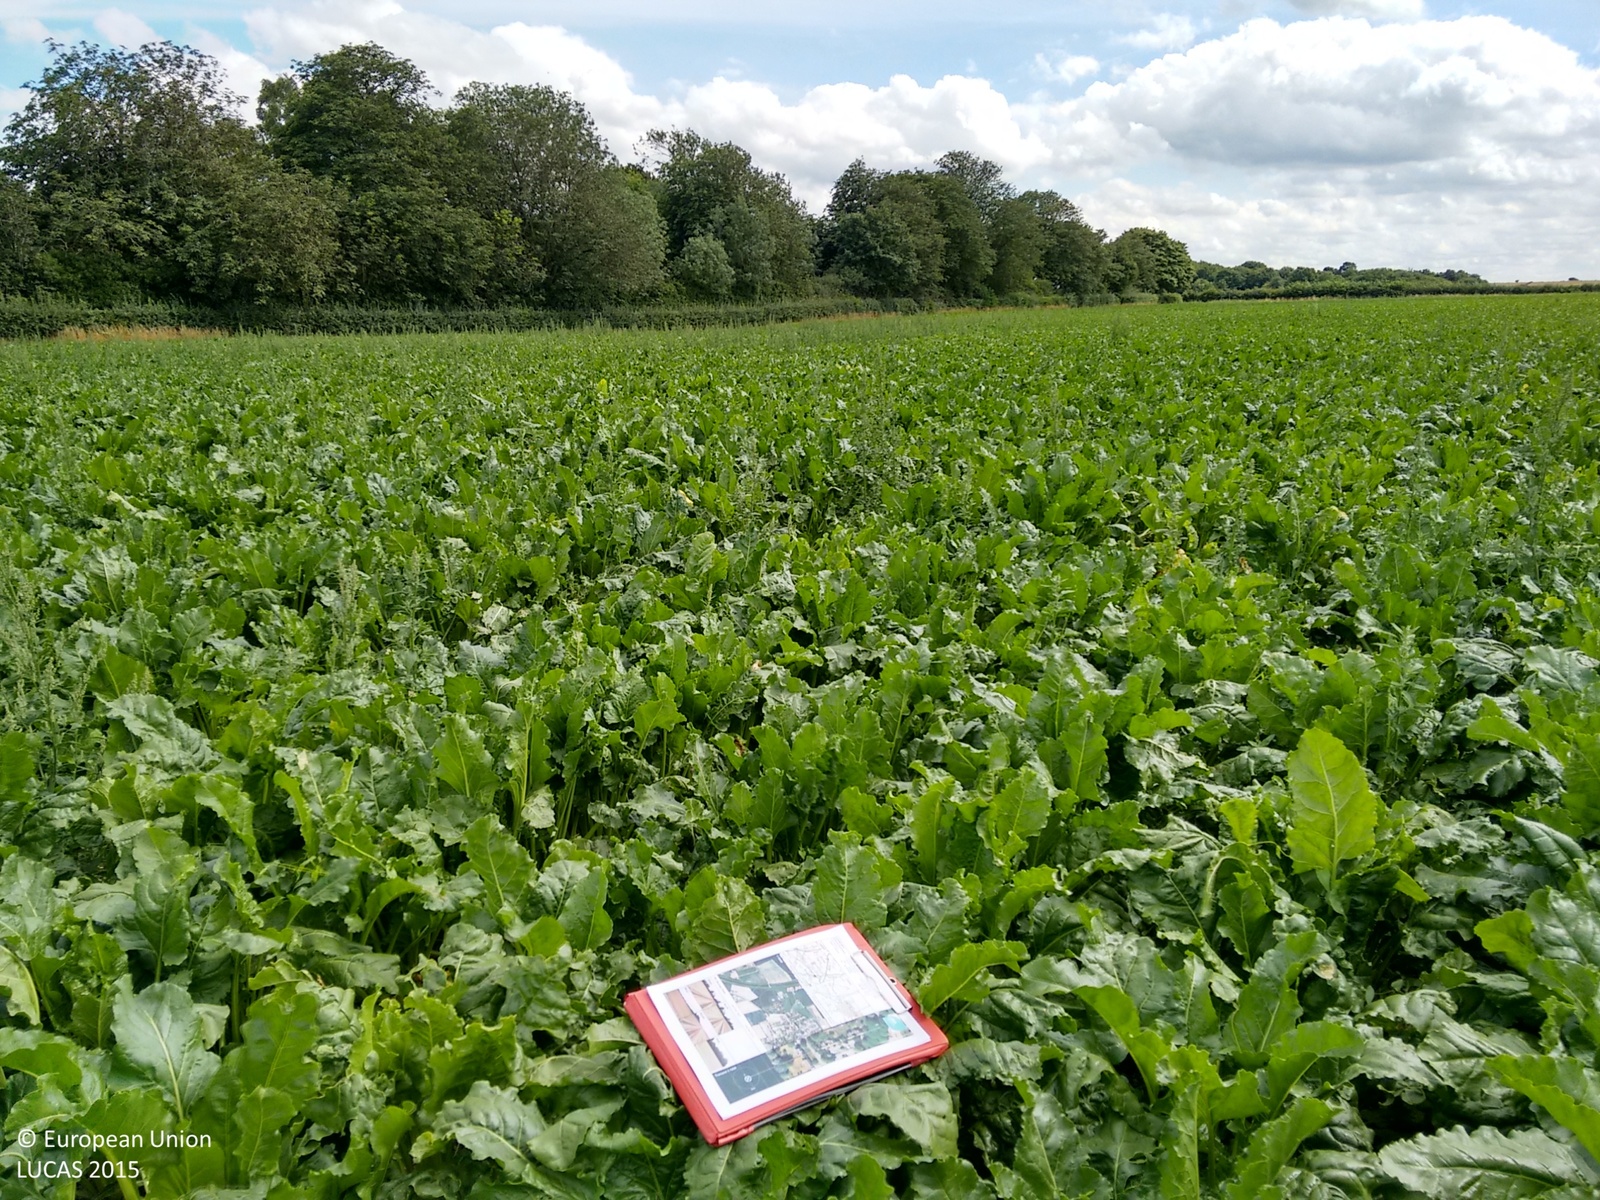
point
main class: Cropland
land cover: Sugar beet
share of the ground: > 75 %
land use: Agriculture (excluding fallow land and kitchen gardens)
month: August
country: GB
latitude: 52.4849
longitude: 0.5039
